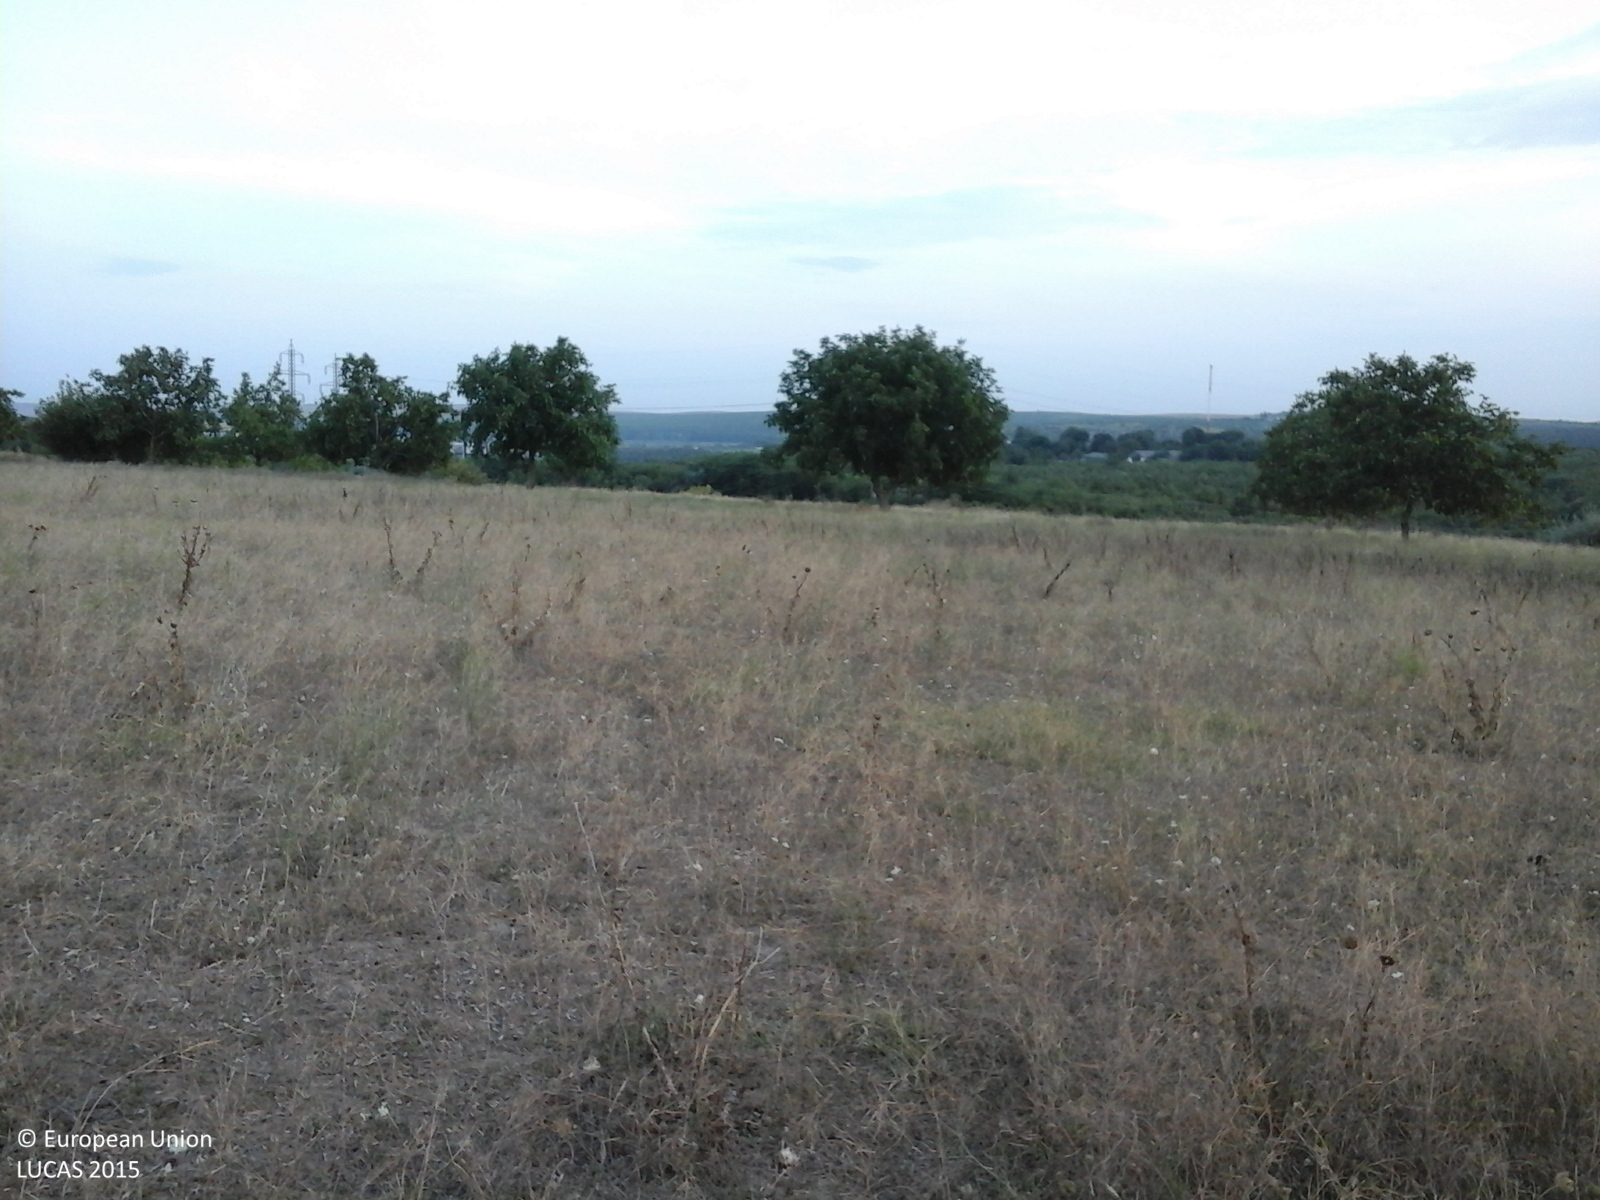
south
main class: Grassland
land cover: Spontaneously vegetated surfaces
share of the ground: > 75 %
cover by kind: herbaceous plants 100 %
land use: Agriculture (excluding fallow land and kitchen gardens)
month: August
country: RO
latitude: 44.3370
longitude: 28.0552
